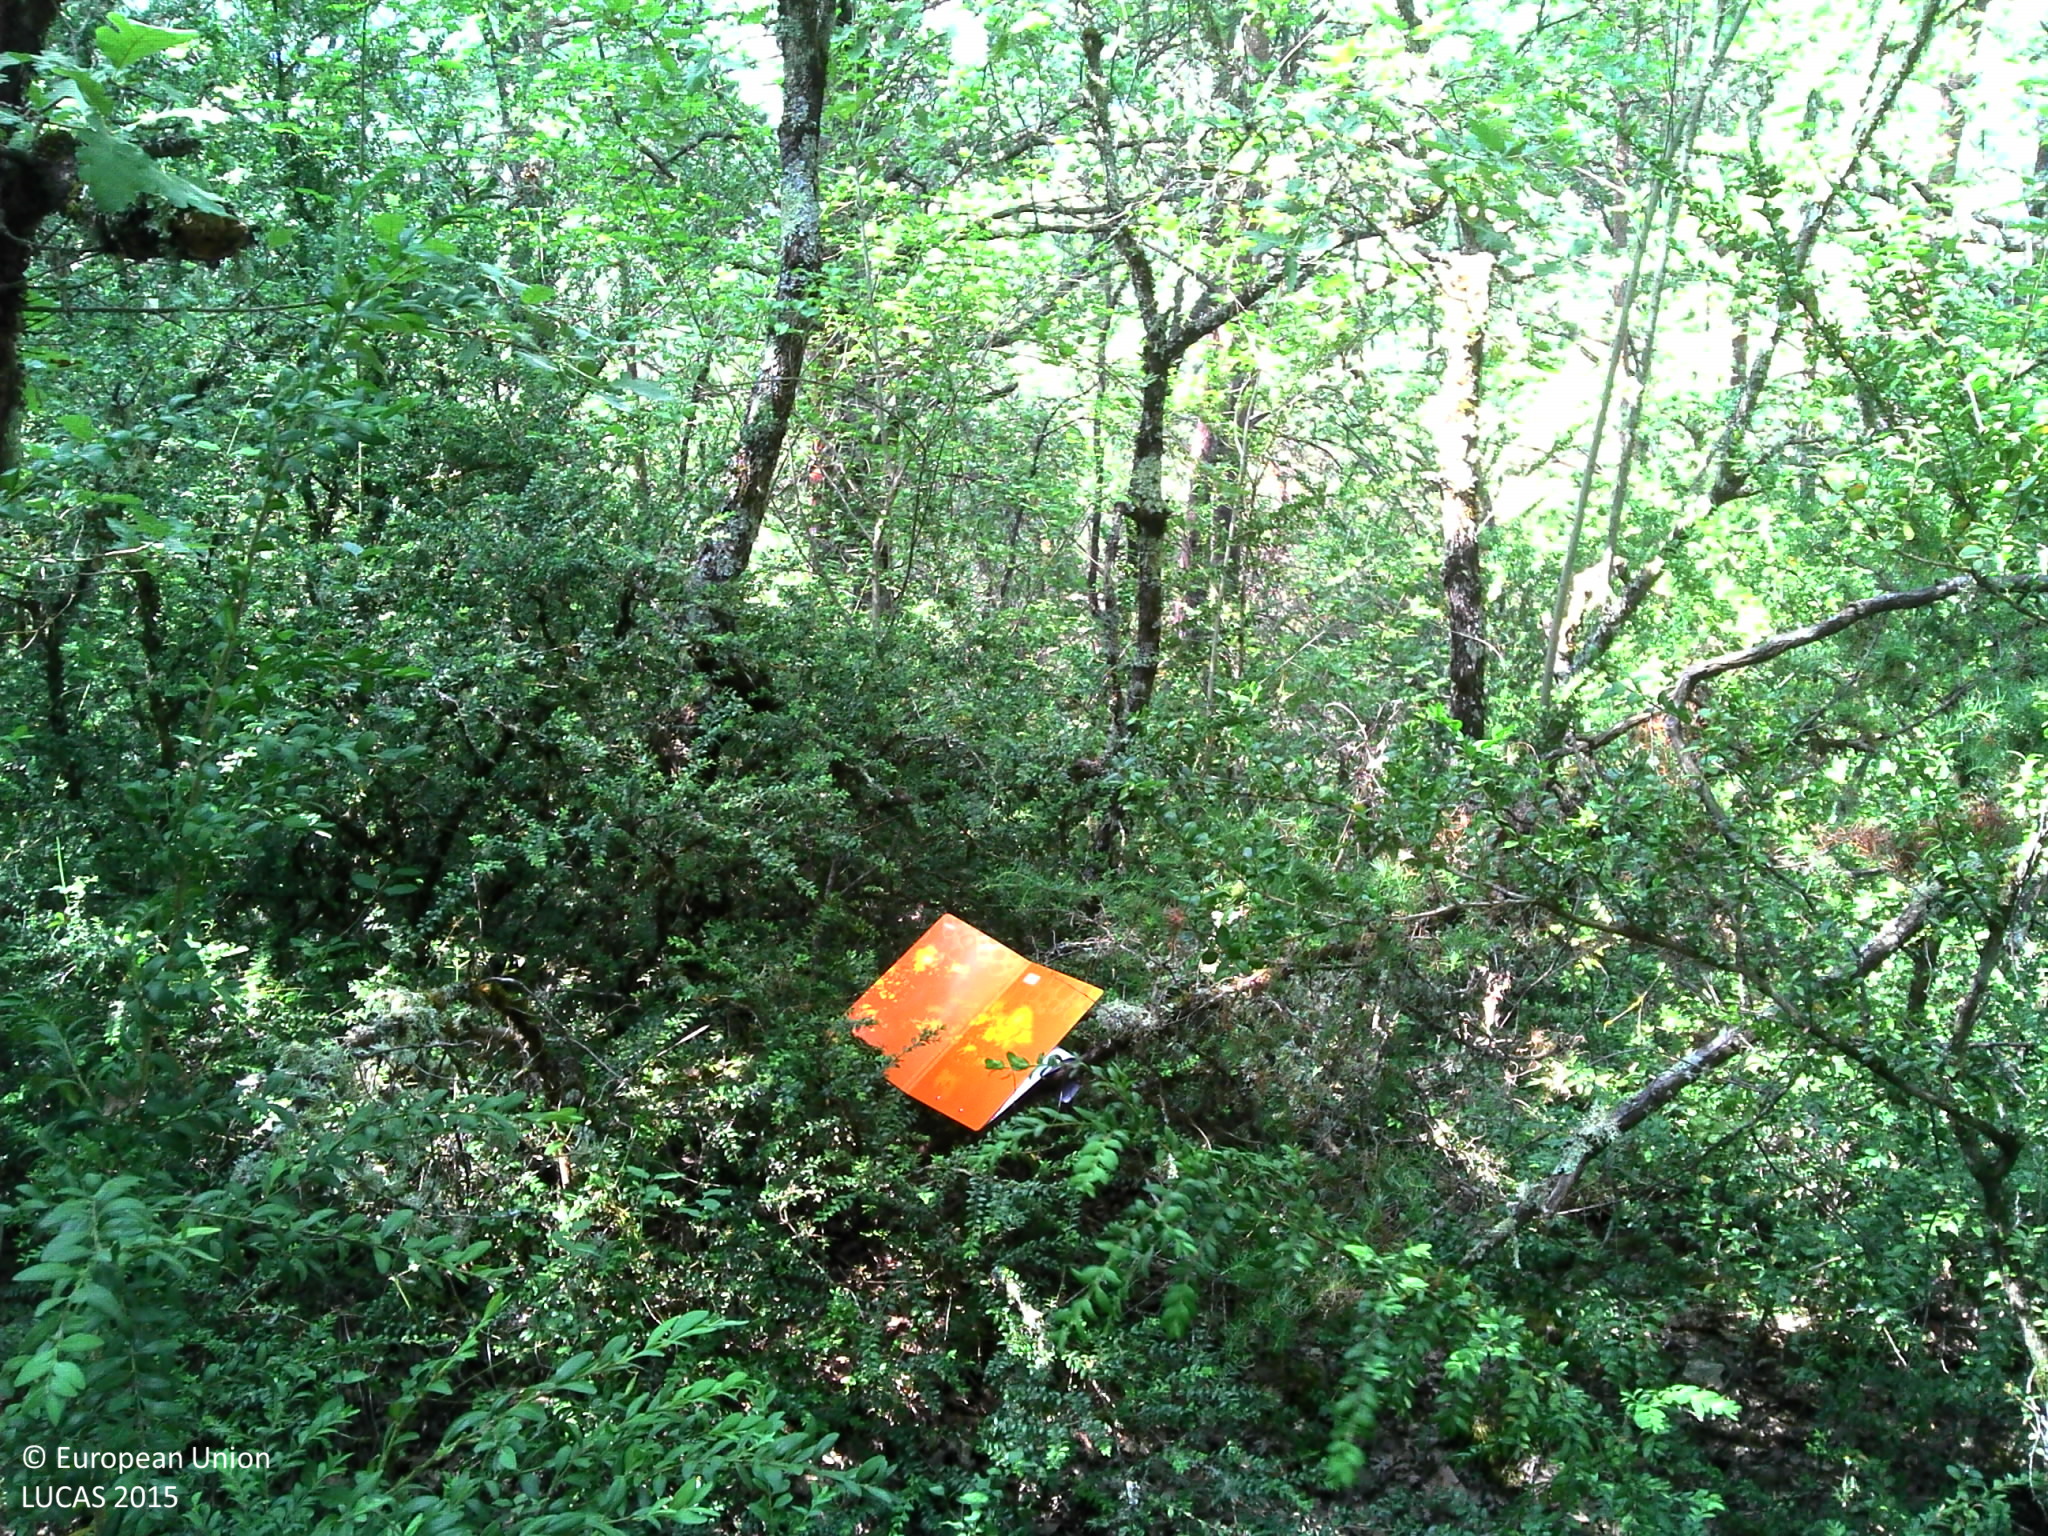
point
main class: Woodland
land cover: Pine dominated mixed woodland
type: coniferous forest of the mediterranean region
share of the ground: > 75 %
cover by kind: coniferous forest trees 40 %, broadleaved forest trees 40 %, shrubs 15 %, herbaceous plants 5 %
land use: Semi-natural and natural areas not in use
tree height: > 5 m
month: July
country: FR
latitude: 43.8426
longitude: 5.6180
